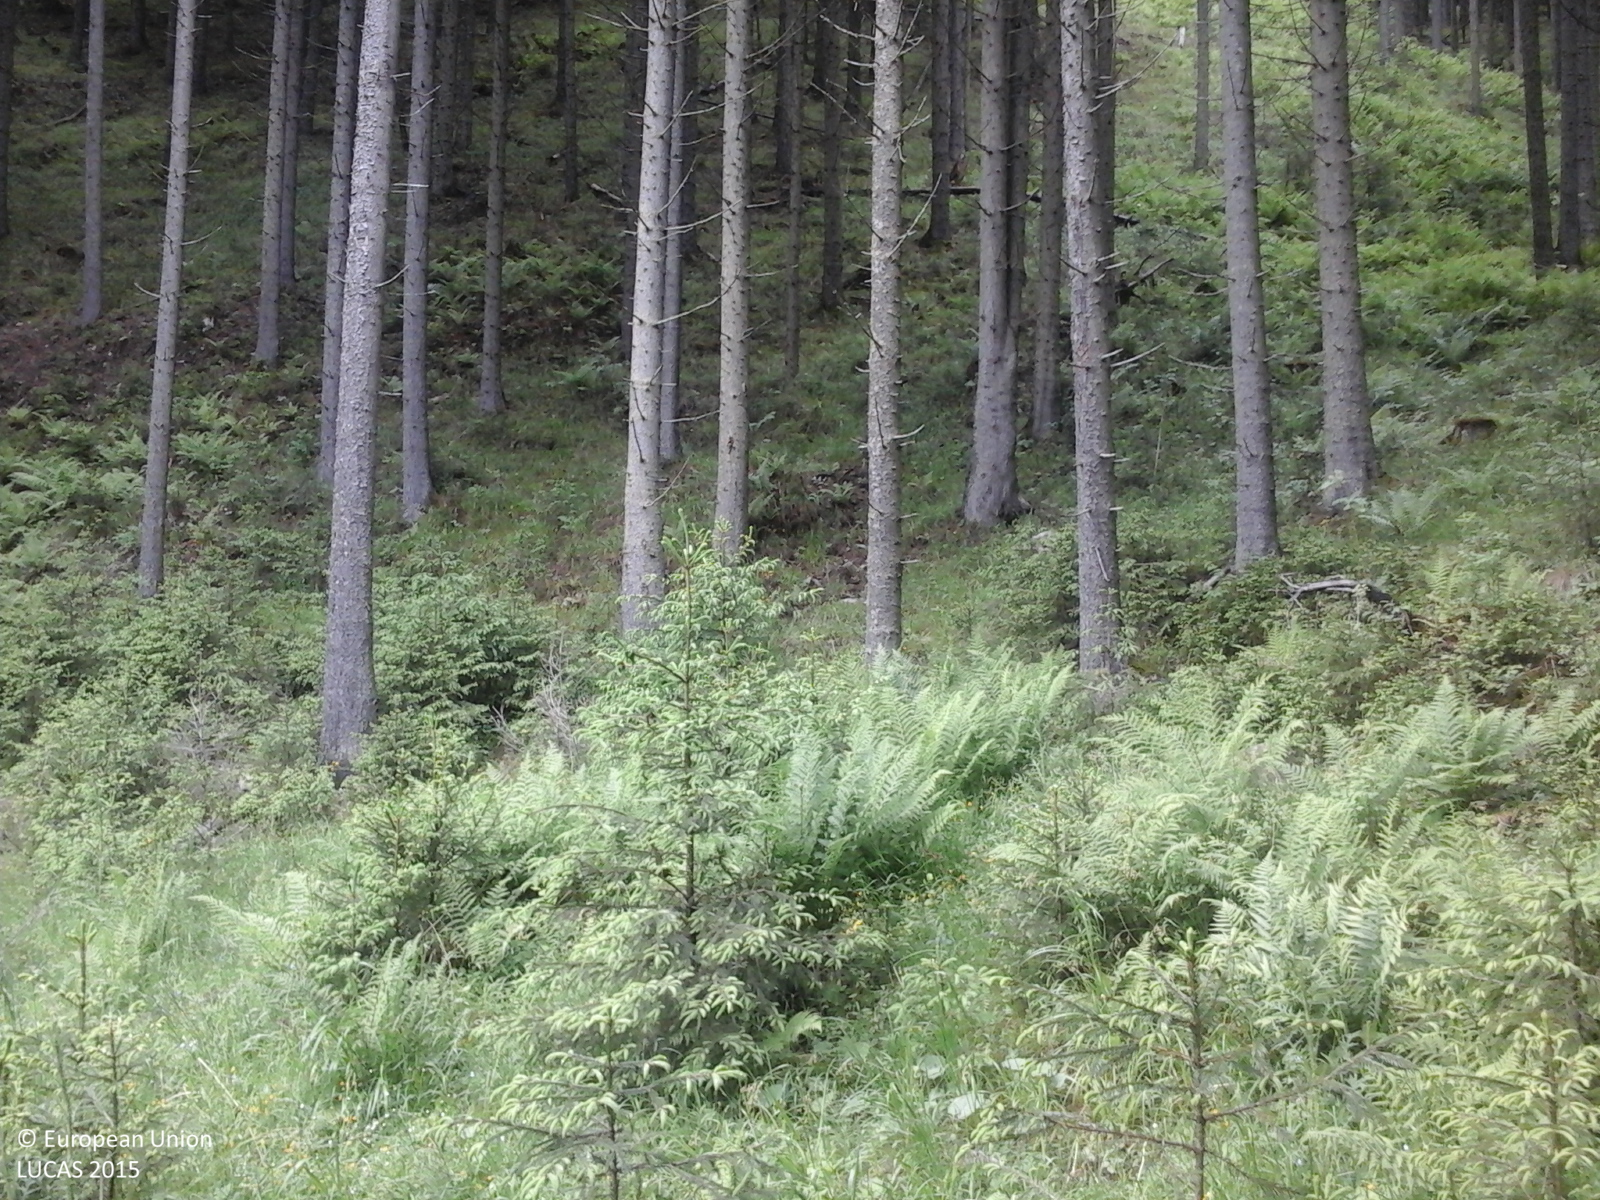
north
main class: Woodland
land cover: Spruce dominated coniferous woodland
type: alpine coniferous forest
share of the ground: > 75 %
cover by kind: coniferous forest trees 85 %, herbaceous plants 10 %, shrubs 5 %
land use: Forestry
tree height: > 5 m
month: June
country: RO
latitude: 47.4208
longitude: 25.1792
